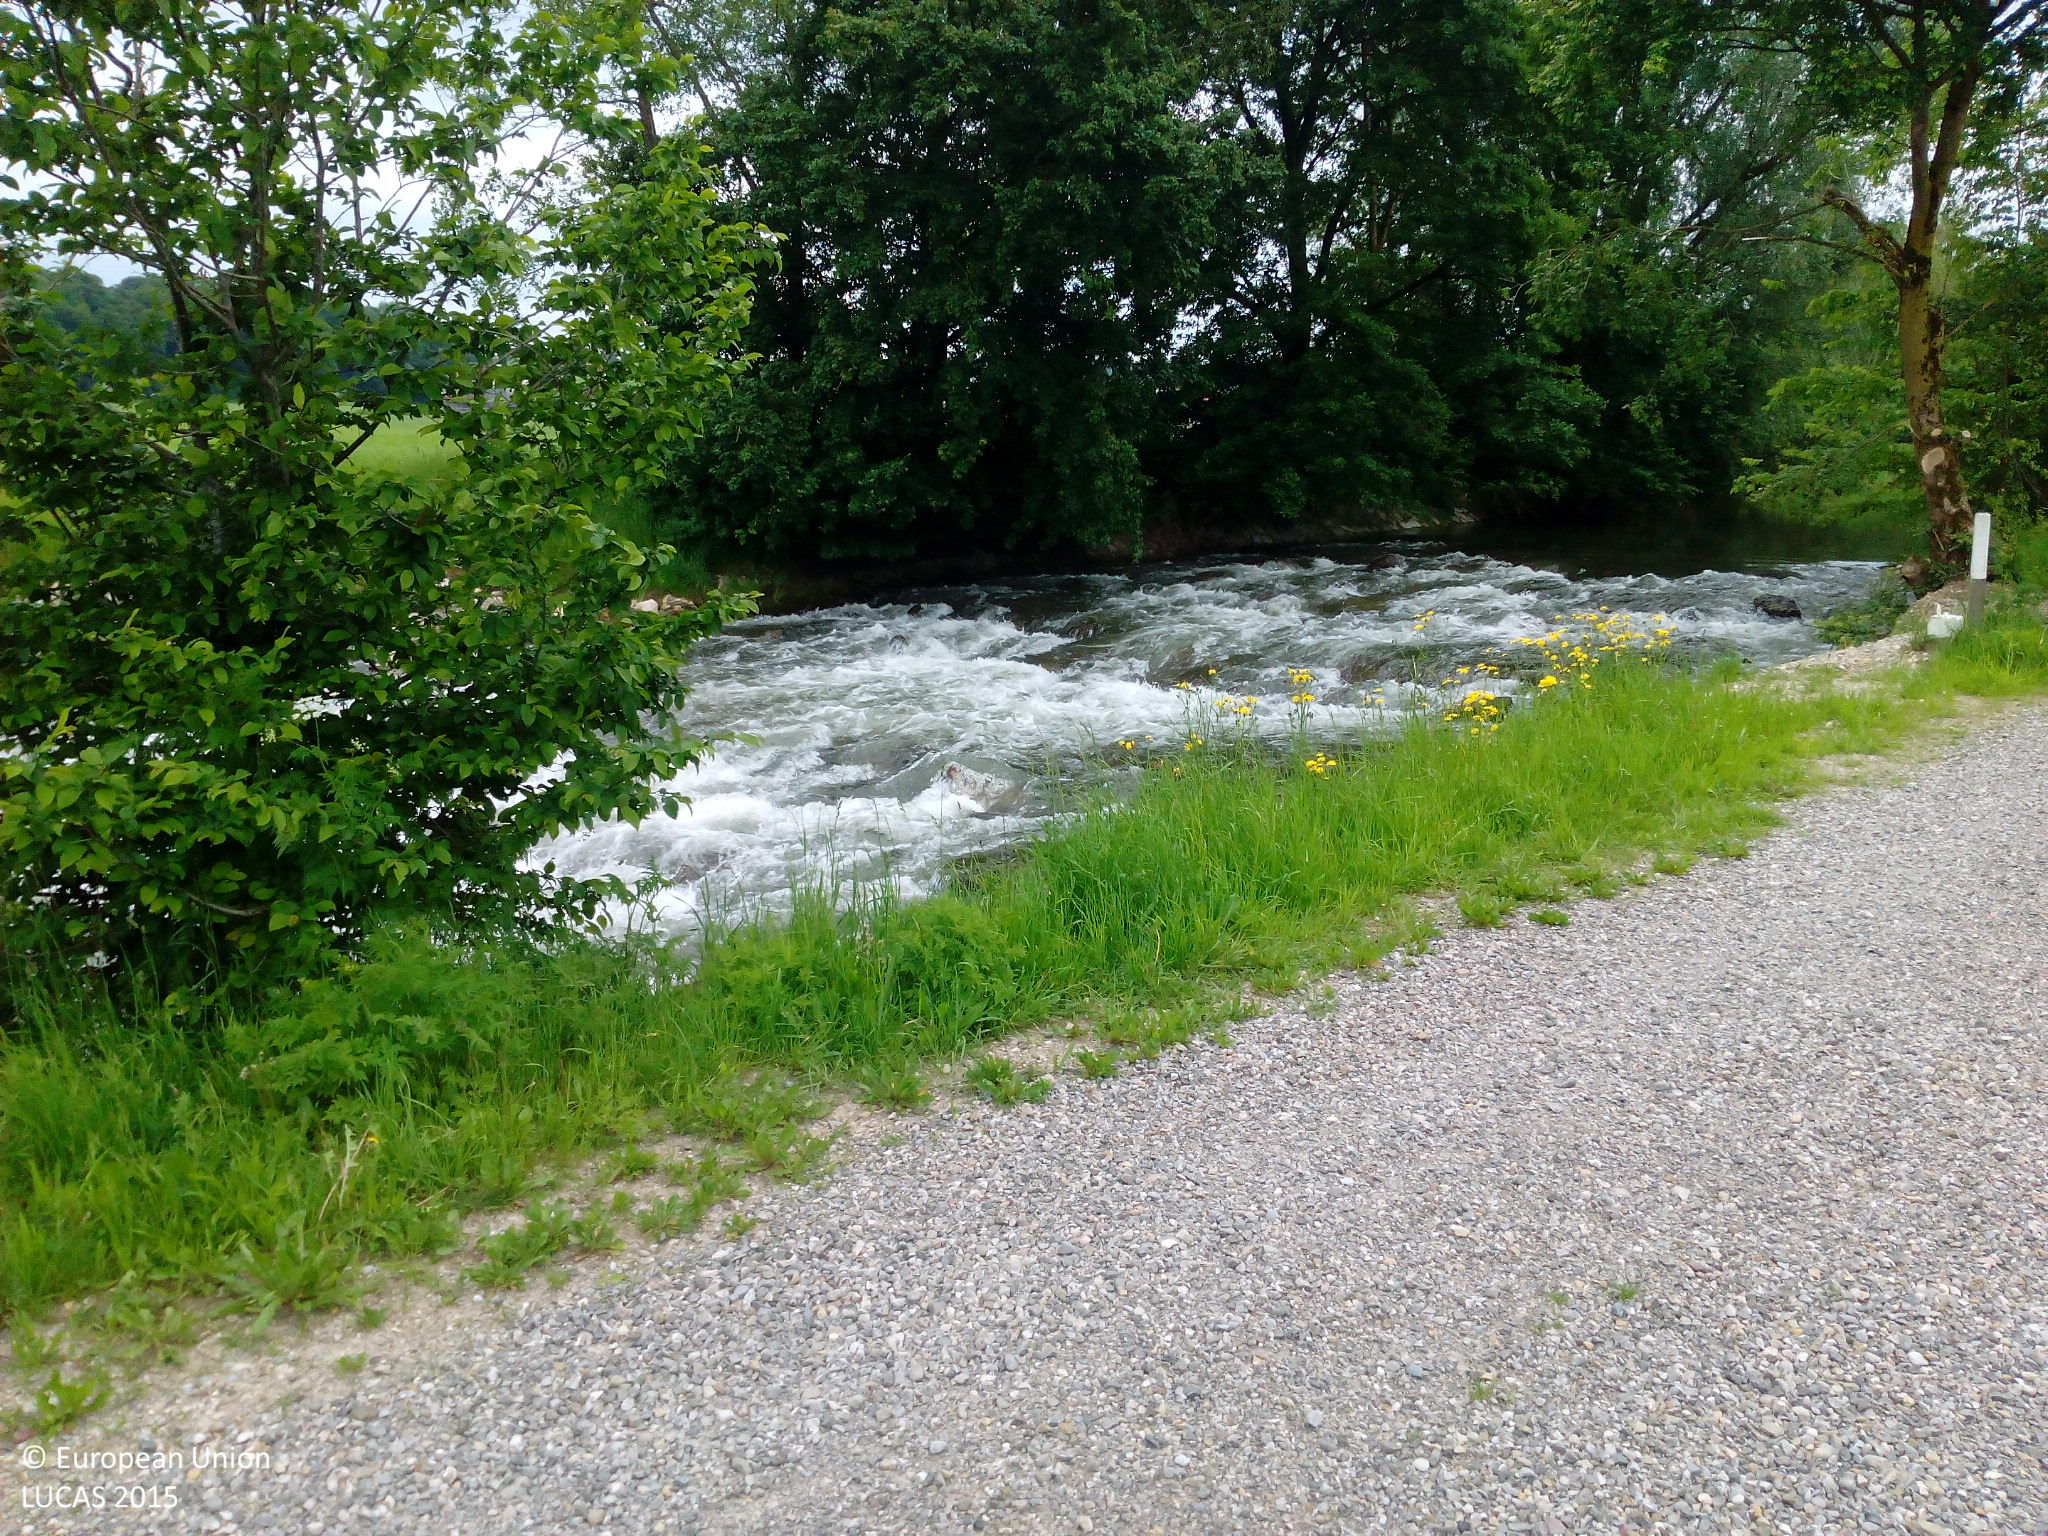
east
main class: Grassland
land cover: Grassland without tree/shrub cover
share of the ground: > 75 %
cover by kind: herbaceous plants 100 %
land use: Agriculture (excluding fallow land and kitchen gardens)
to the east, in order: Grassland without tree/shrub cover; Fences; Grass margins; Tracks; Abandoned hedges; Inland fresh running water; Broadleaved woodland; Grassland without tree/shrub cover
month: May
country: DE
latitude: 48.1333
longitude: 10.2551
